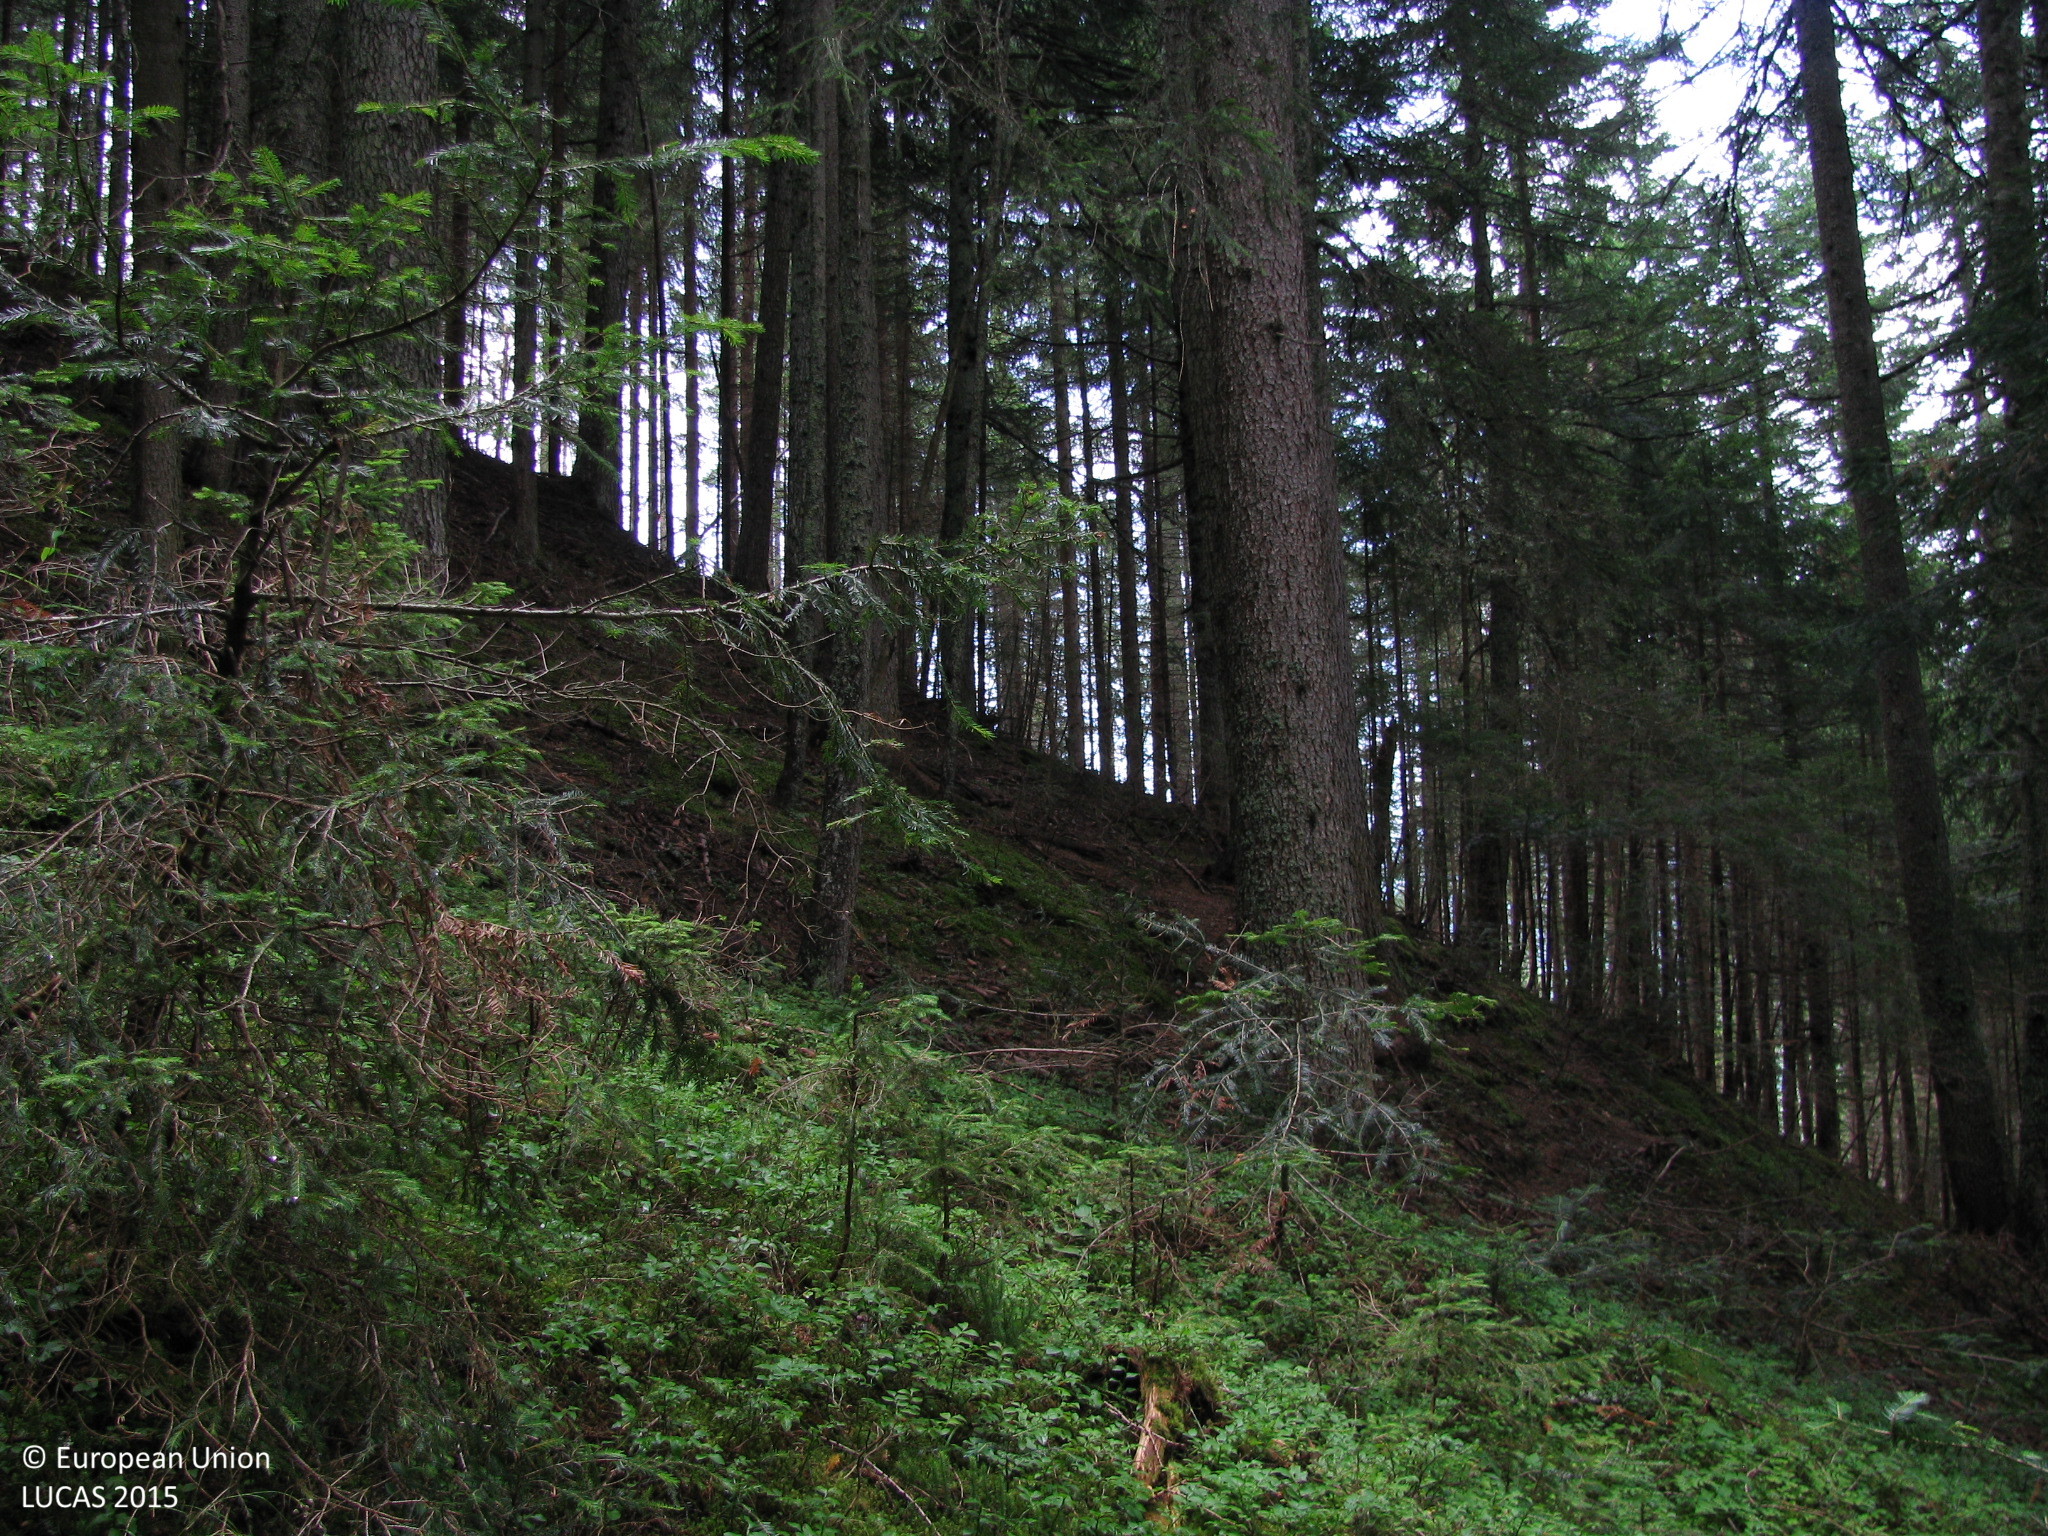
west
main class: Woodland
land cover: Spruce dominated coniferous woodland
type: alpine coniferous forest
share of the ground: > 75 %
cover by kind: coniferous forest trees 75 %, shrubs 10 %, herbaceous plants 10 %, lichens and mosses 5 %
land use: Forestry
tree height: > 5 m
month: July
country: AT
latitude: 46.7377
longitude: 12.4449
